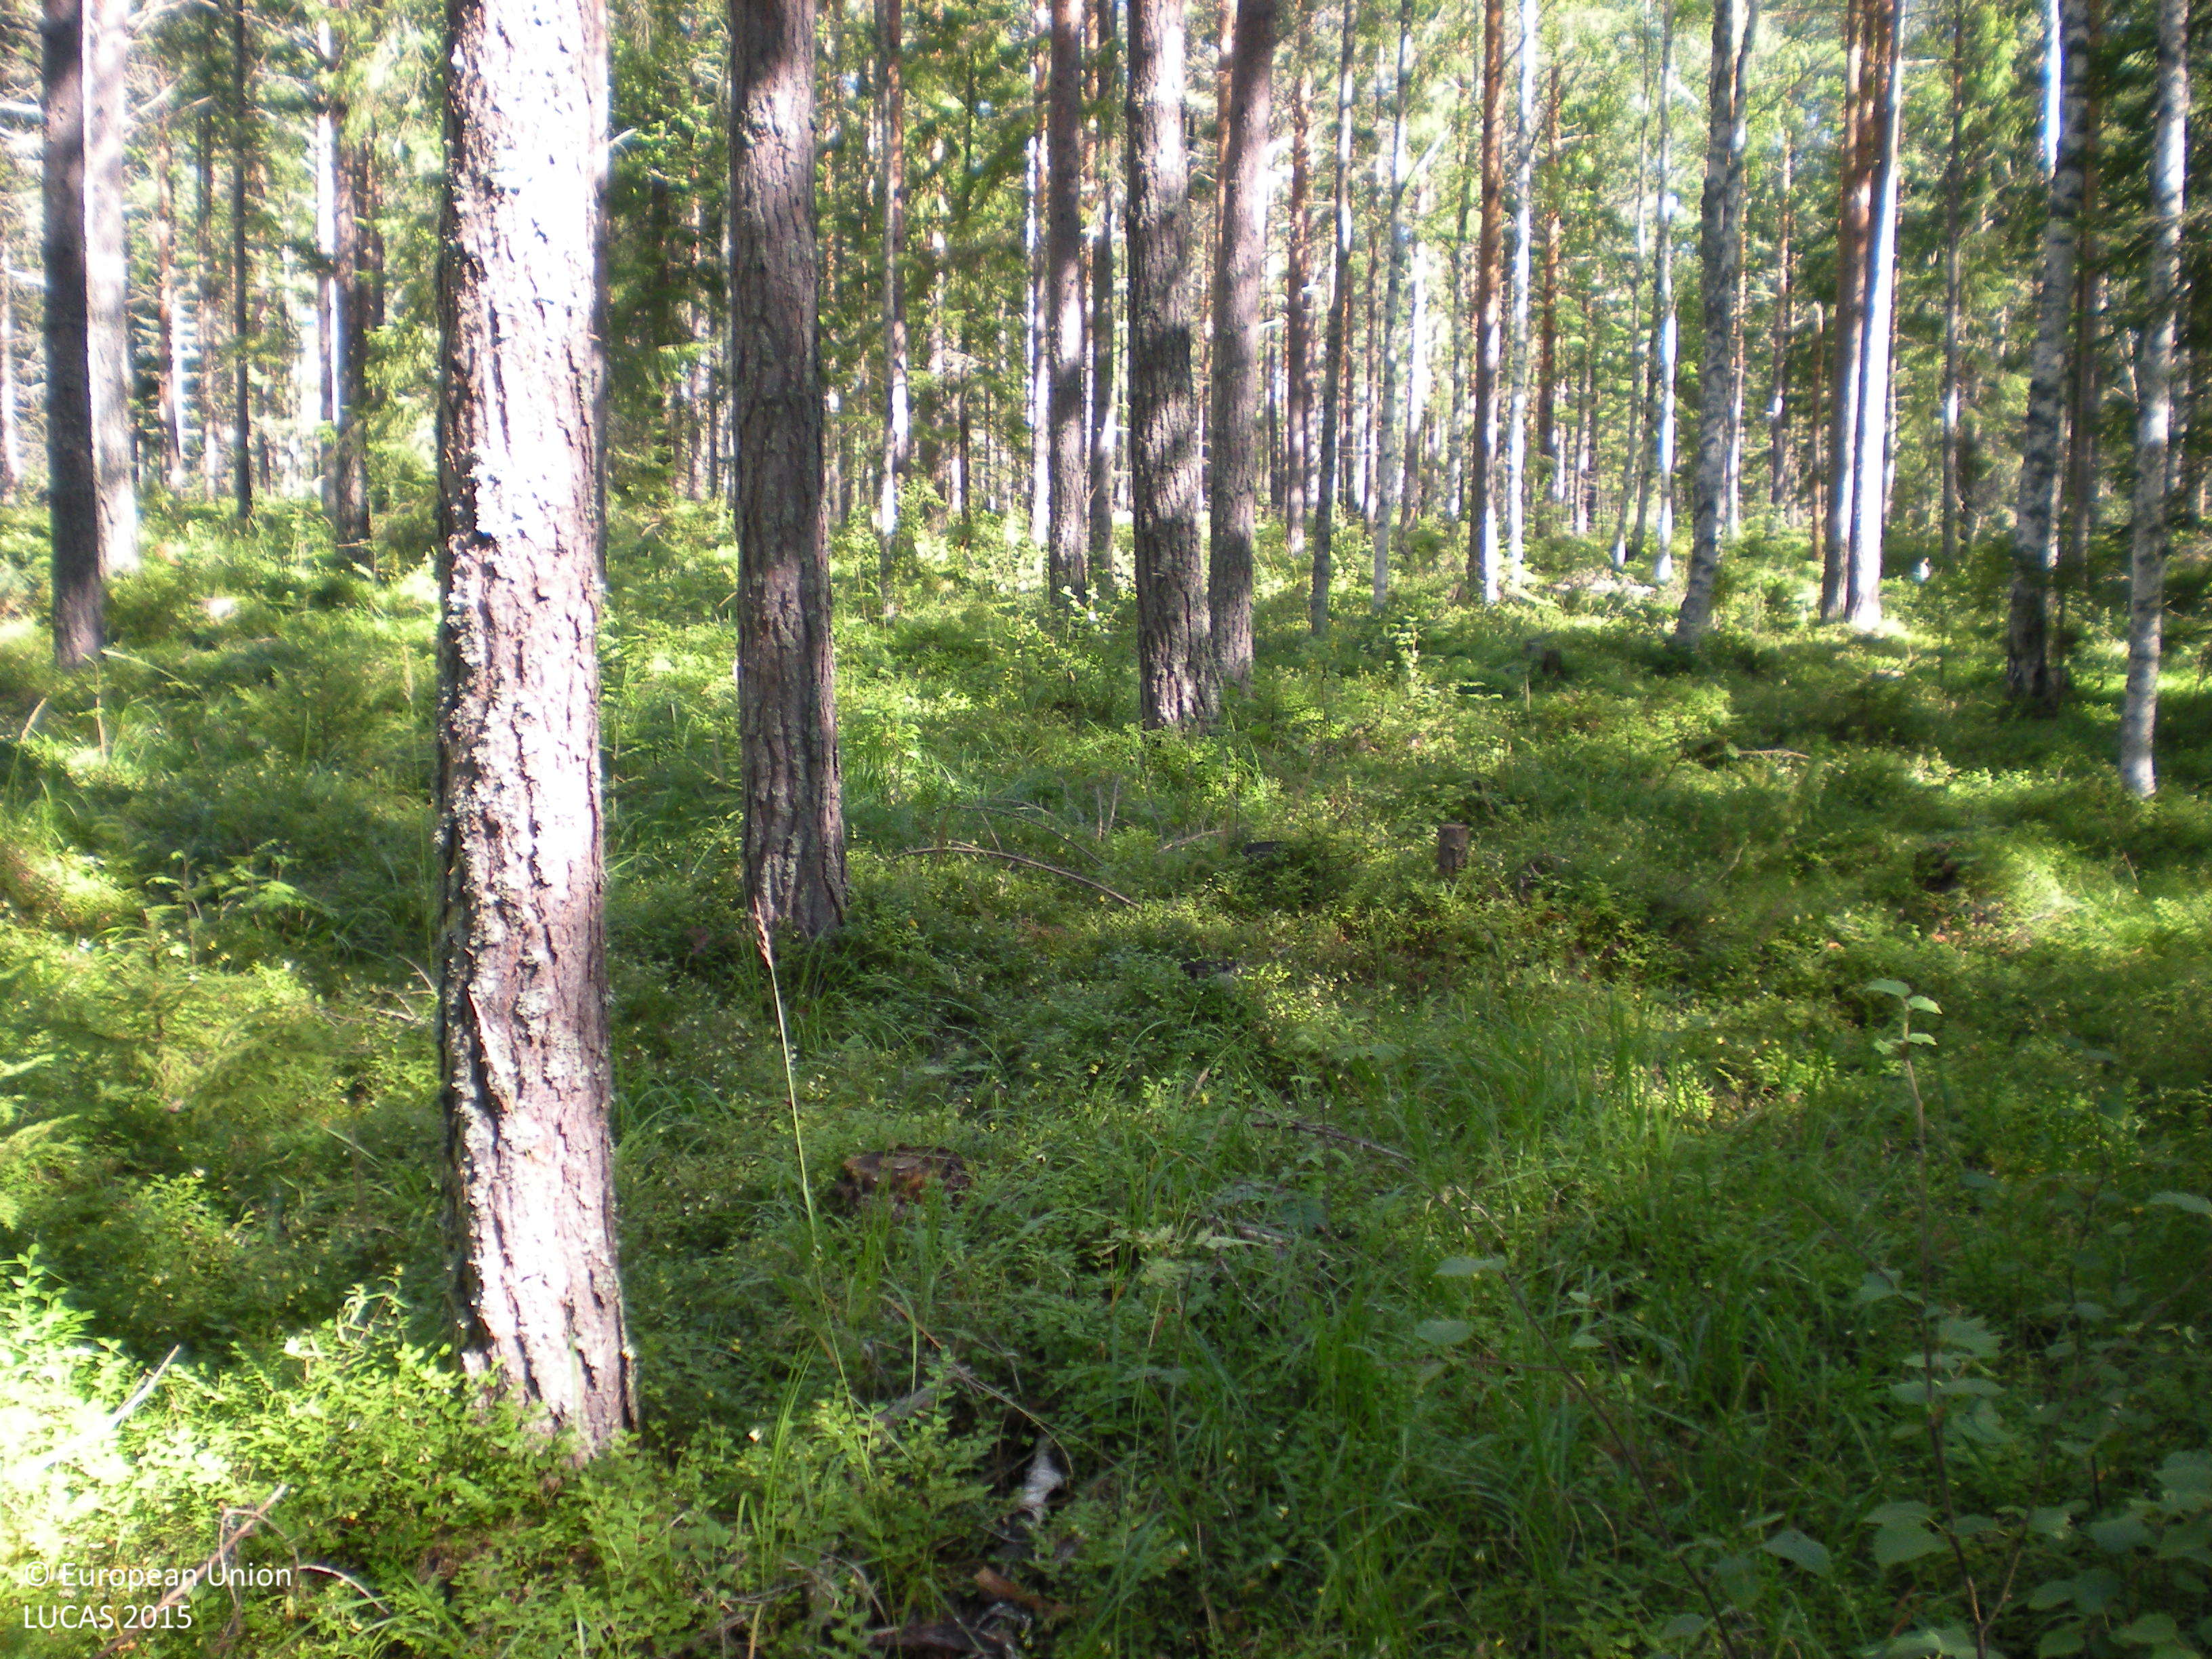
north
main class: Woodland
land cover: Pine dominated coniferous woodland
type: boreal forest
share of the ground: 50 - 75 %
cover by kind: coniferous forest trees 60 %, shrubs 20 %, broadleaved forest trees 10 %, herbaceous plants 5 %, lichens and mosses 5 %
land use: Forestry
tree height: > 5 m
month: August
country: SE
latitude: 60.7601
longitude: 17.1278
